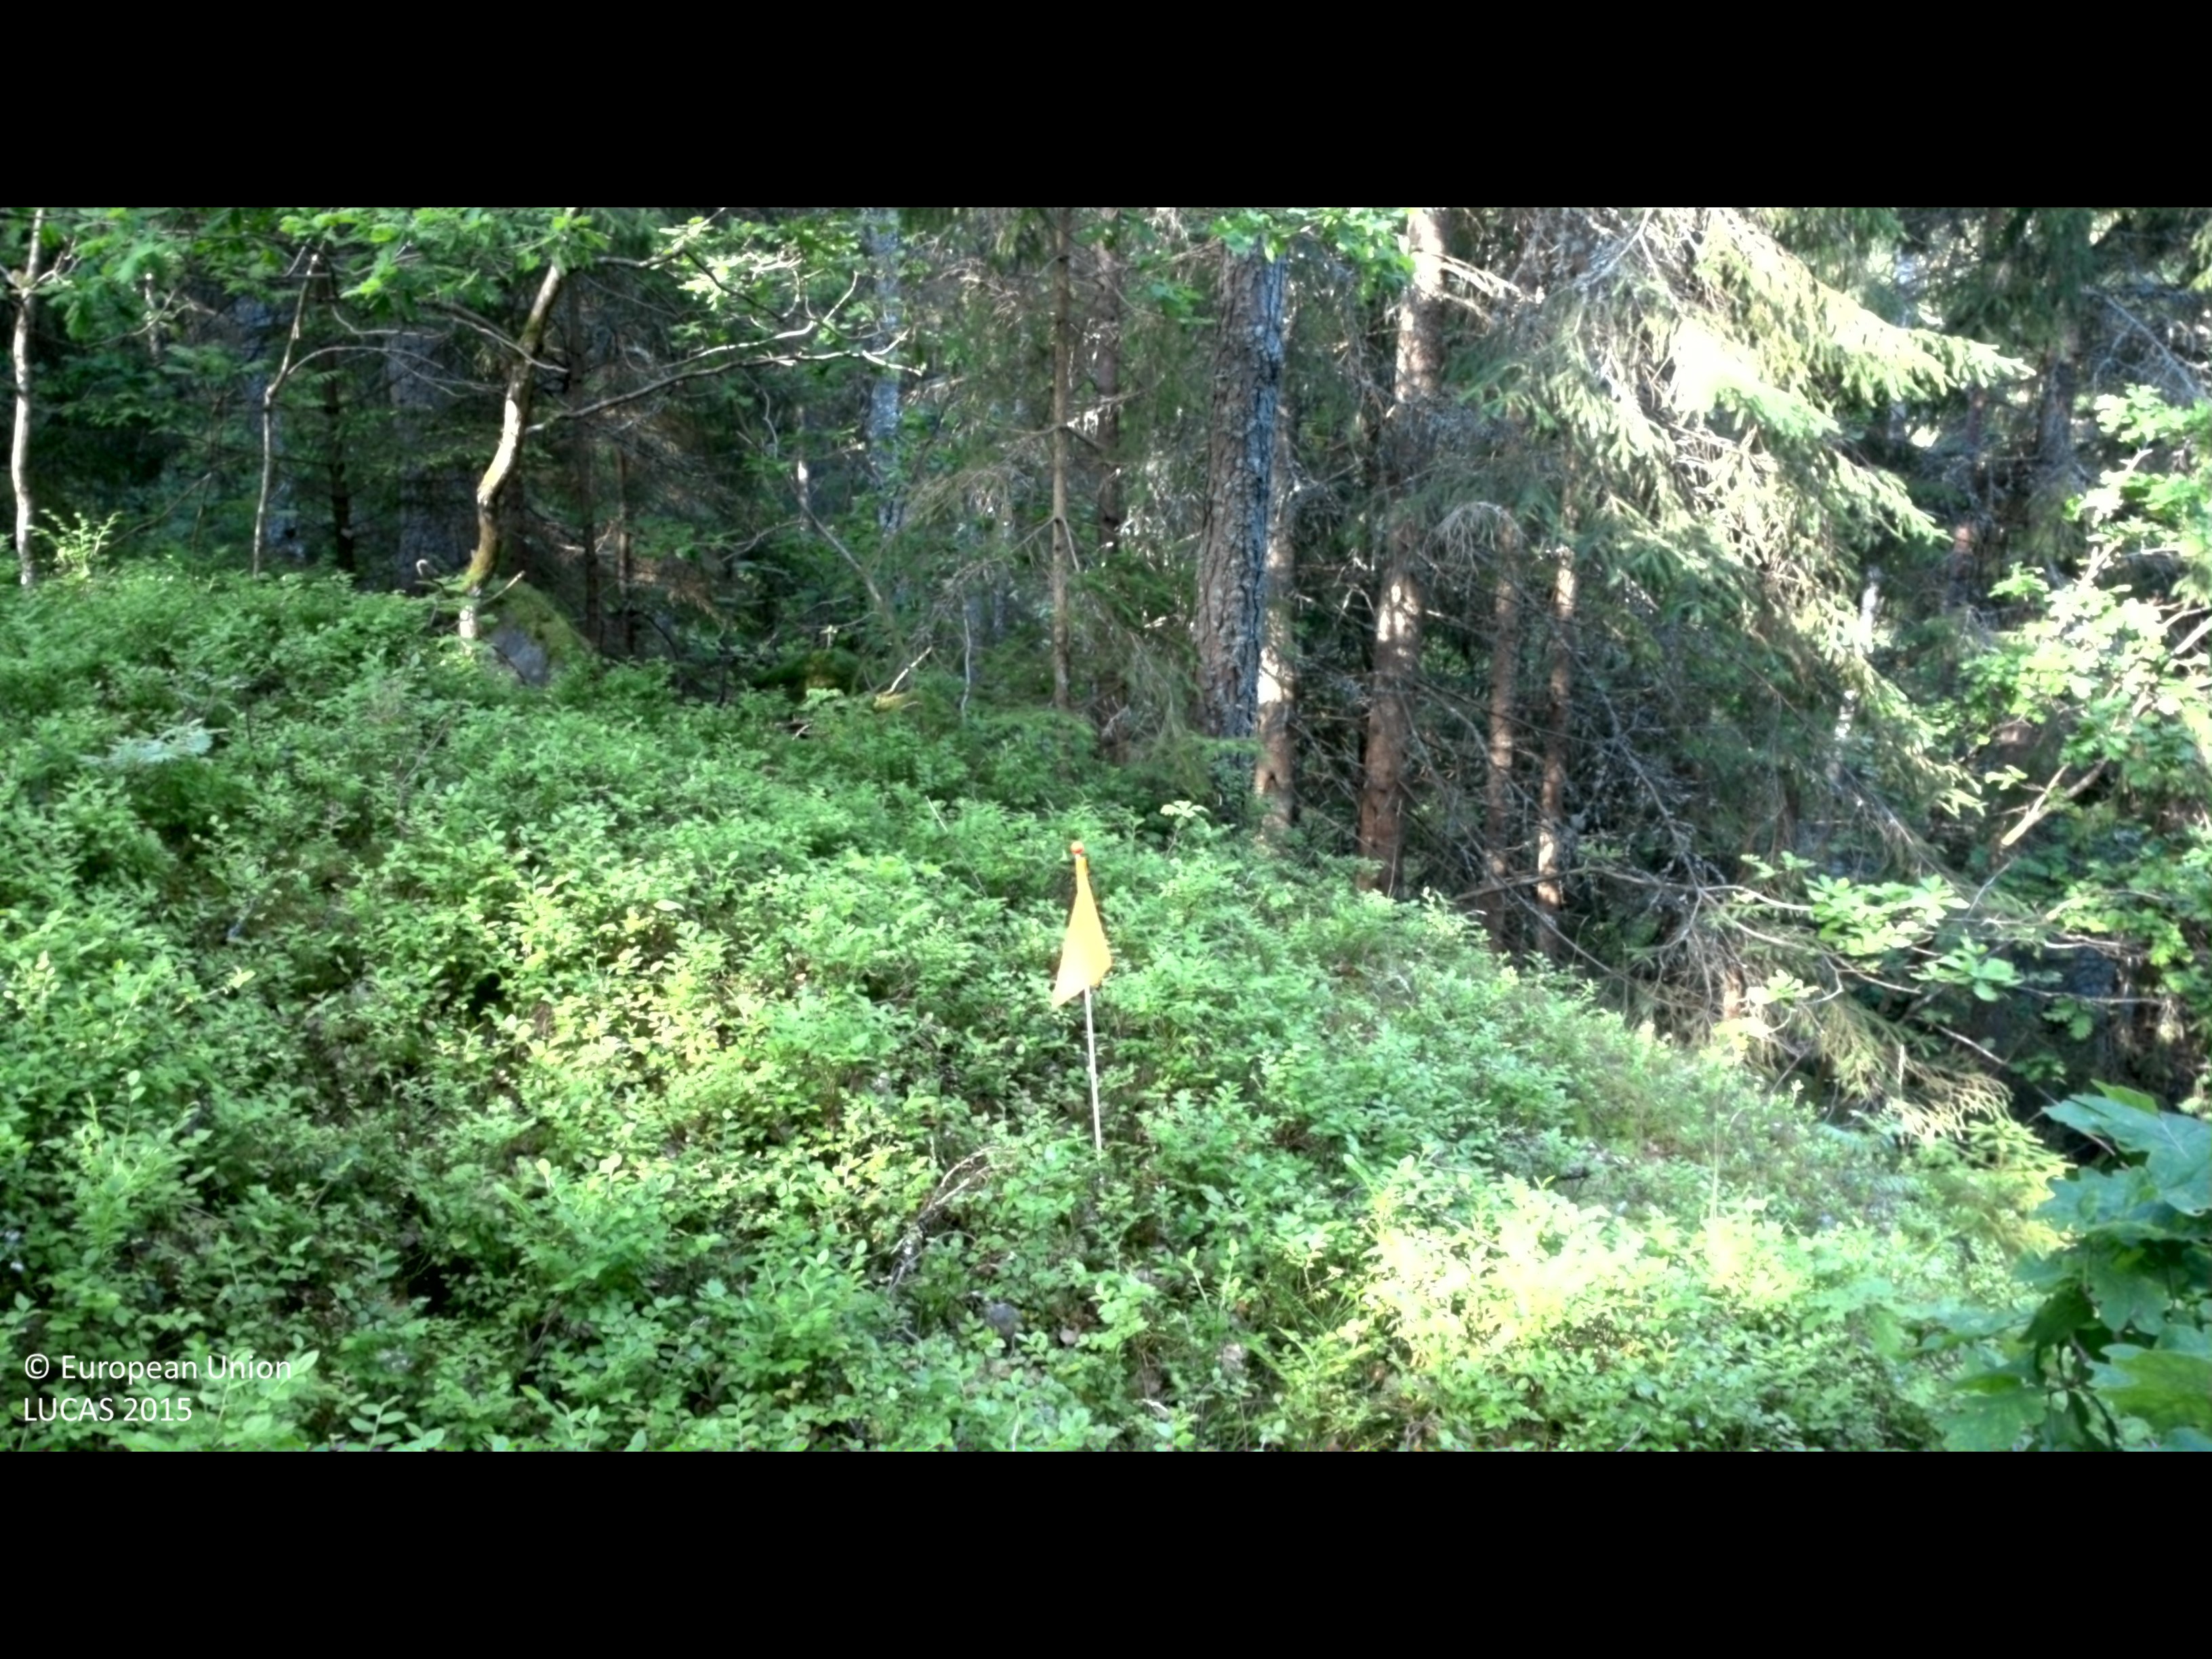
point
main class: Woodland
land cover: Spruce dominated coniferous woodland
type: boreal forest
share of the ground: 50 - 75 %
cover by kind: coniferous forest trees 65 %, shrubs 25 %, broadleaved forest trees 10 %
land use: Forestry
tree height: > 5 m
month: June
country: SE
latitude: 58.1702
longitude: 16.5082
